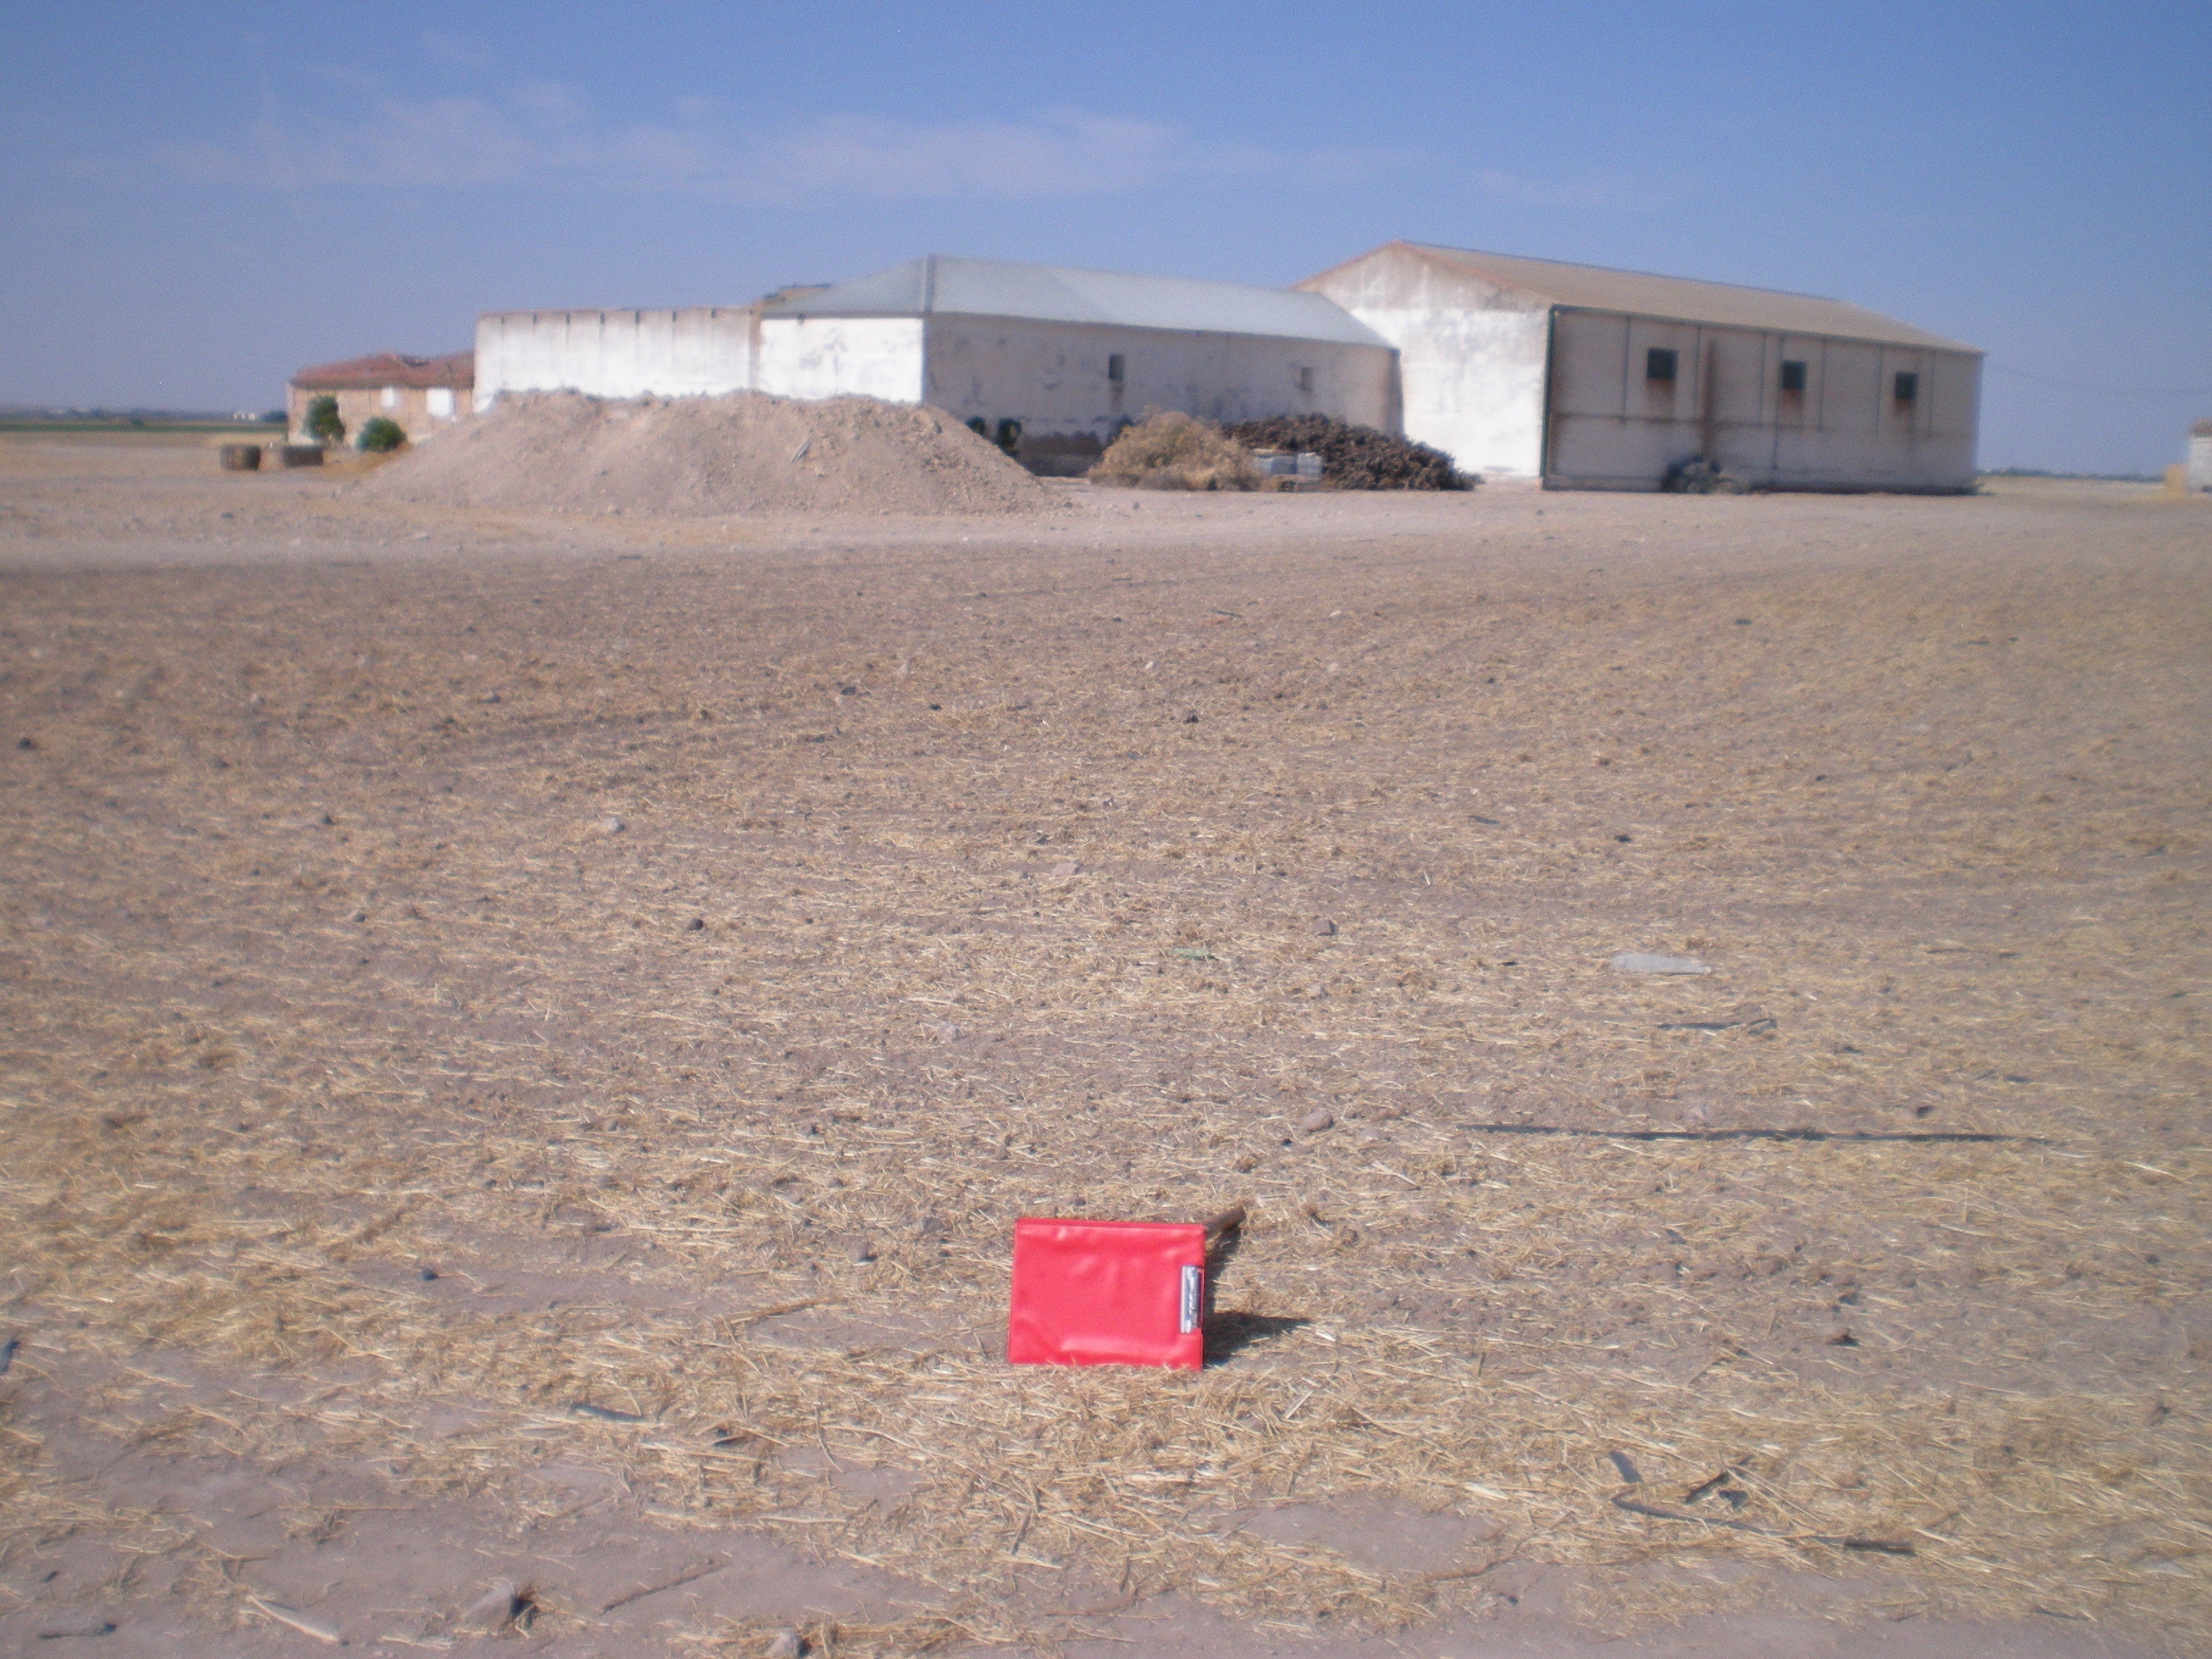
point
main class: Cropland
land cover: Barley
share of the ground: < 10 %
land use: Agriculture (excluding fallow land and kitchen gardens)
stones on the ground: < 10 %
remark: Harvested field
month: July
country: ES
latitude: 39.3103
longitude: -3.1093
